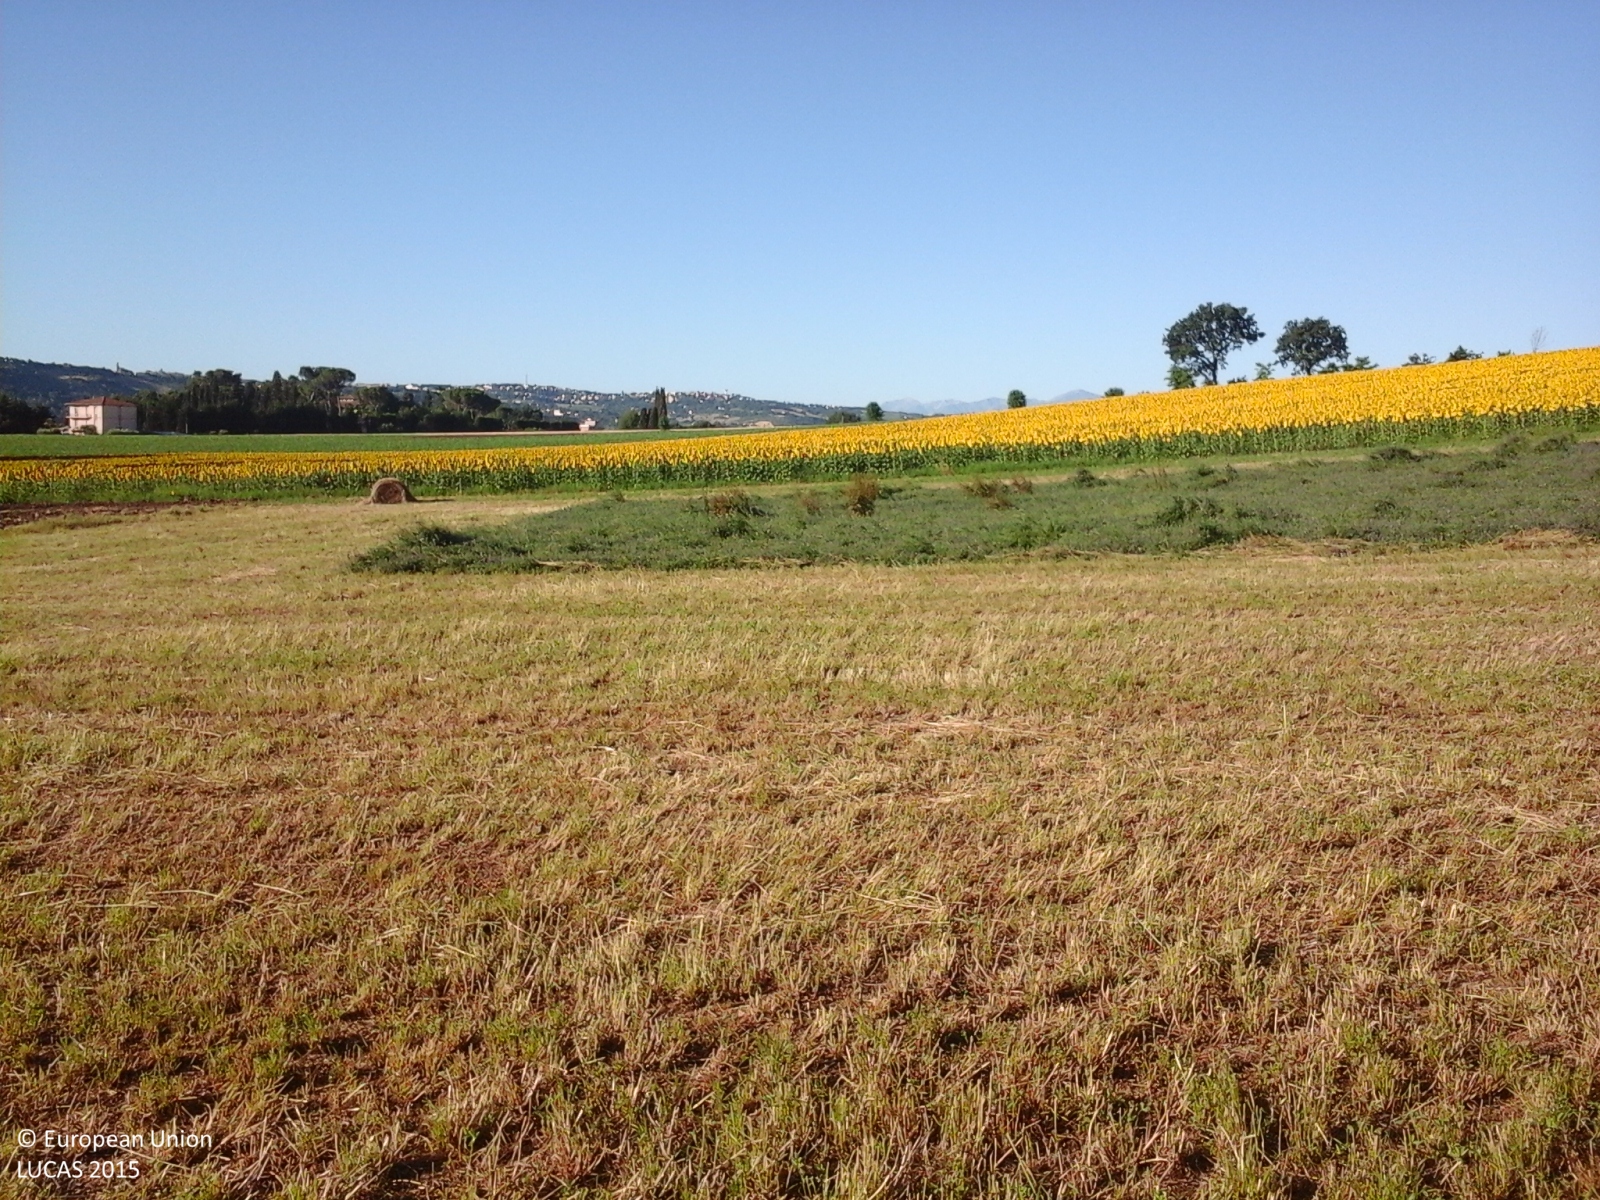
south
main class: Cropland
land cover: Lucerne
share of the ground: > 75 %
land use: Agriculture (excluding fallow land and kitchen gardens)
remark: Harvested field
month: June
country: IT
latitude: 43.3548
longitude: 13.4336
